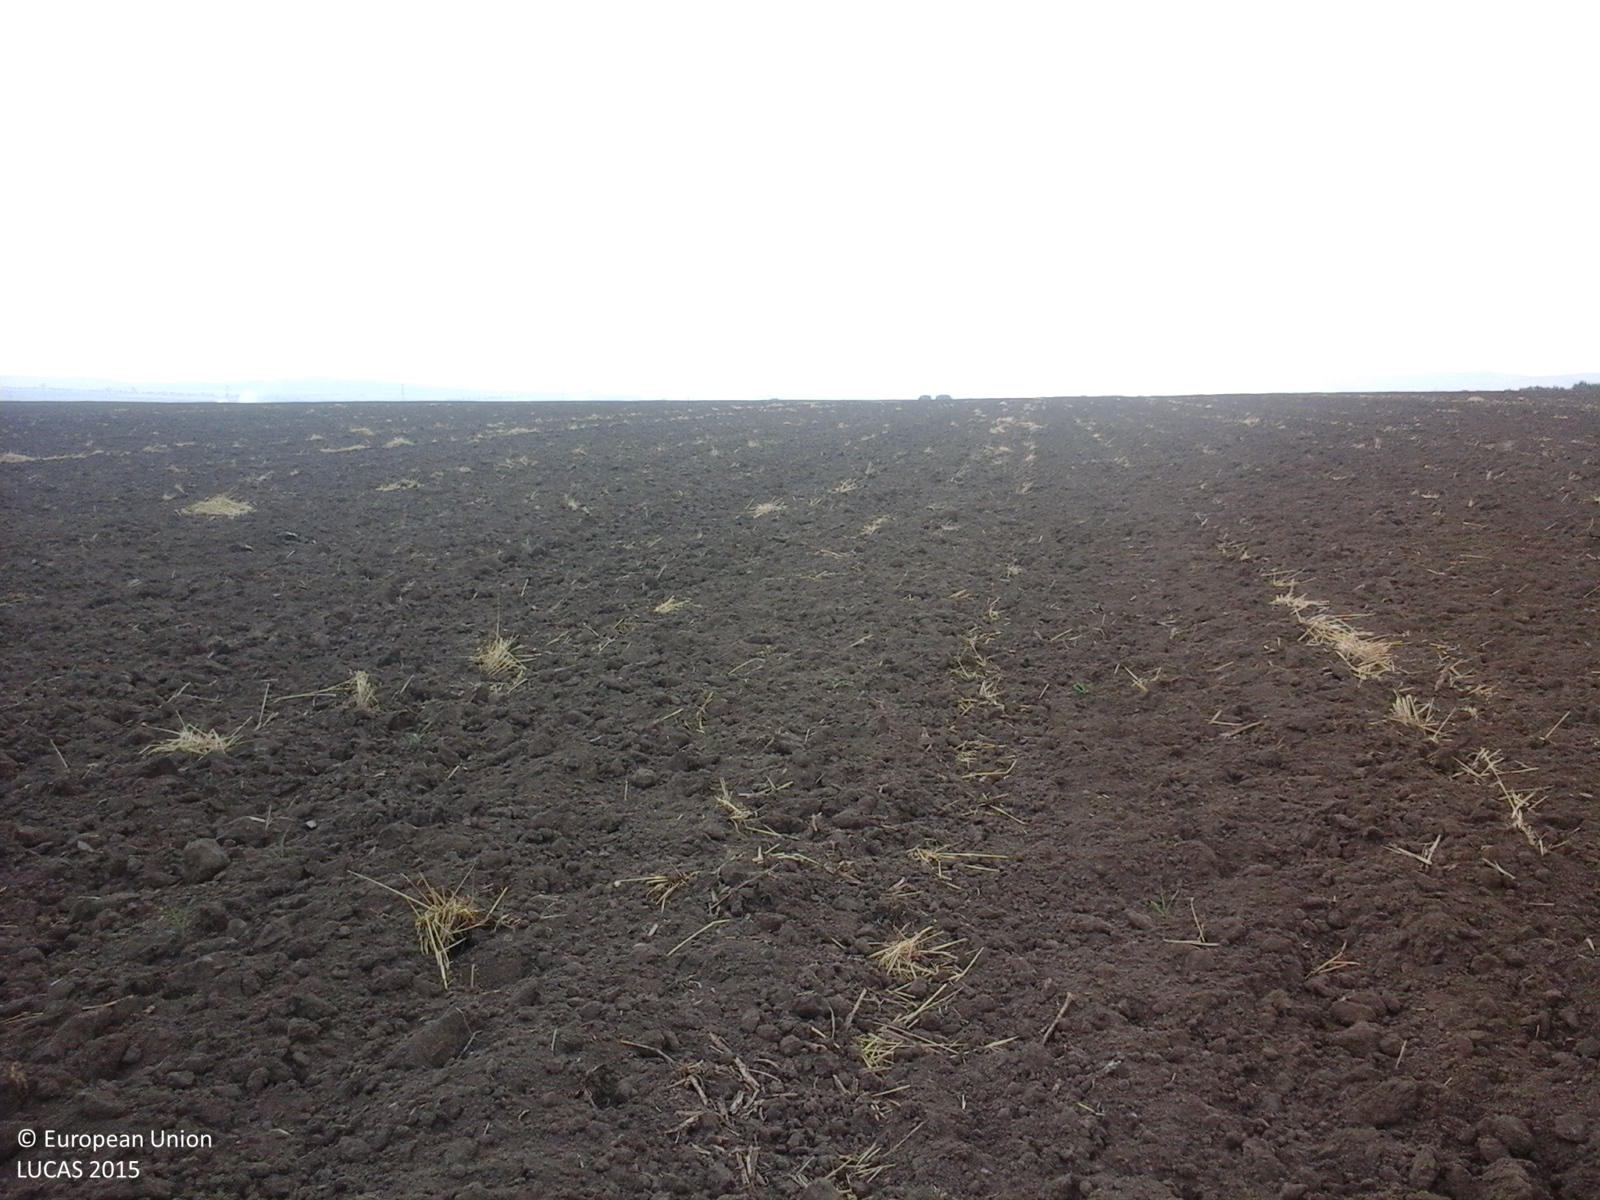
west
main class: Cropland
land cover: Common wheat
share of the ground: < 10 %
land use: Agriculture (excluding fallow land and kitchen gardens)
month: July
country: RO
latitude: 45.0589
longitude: 28.6626
